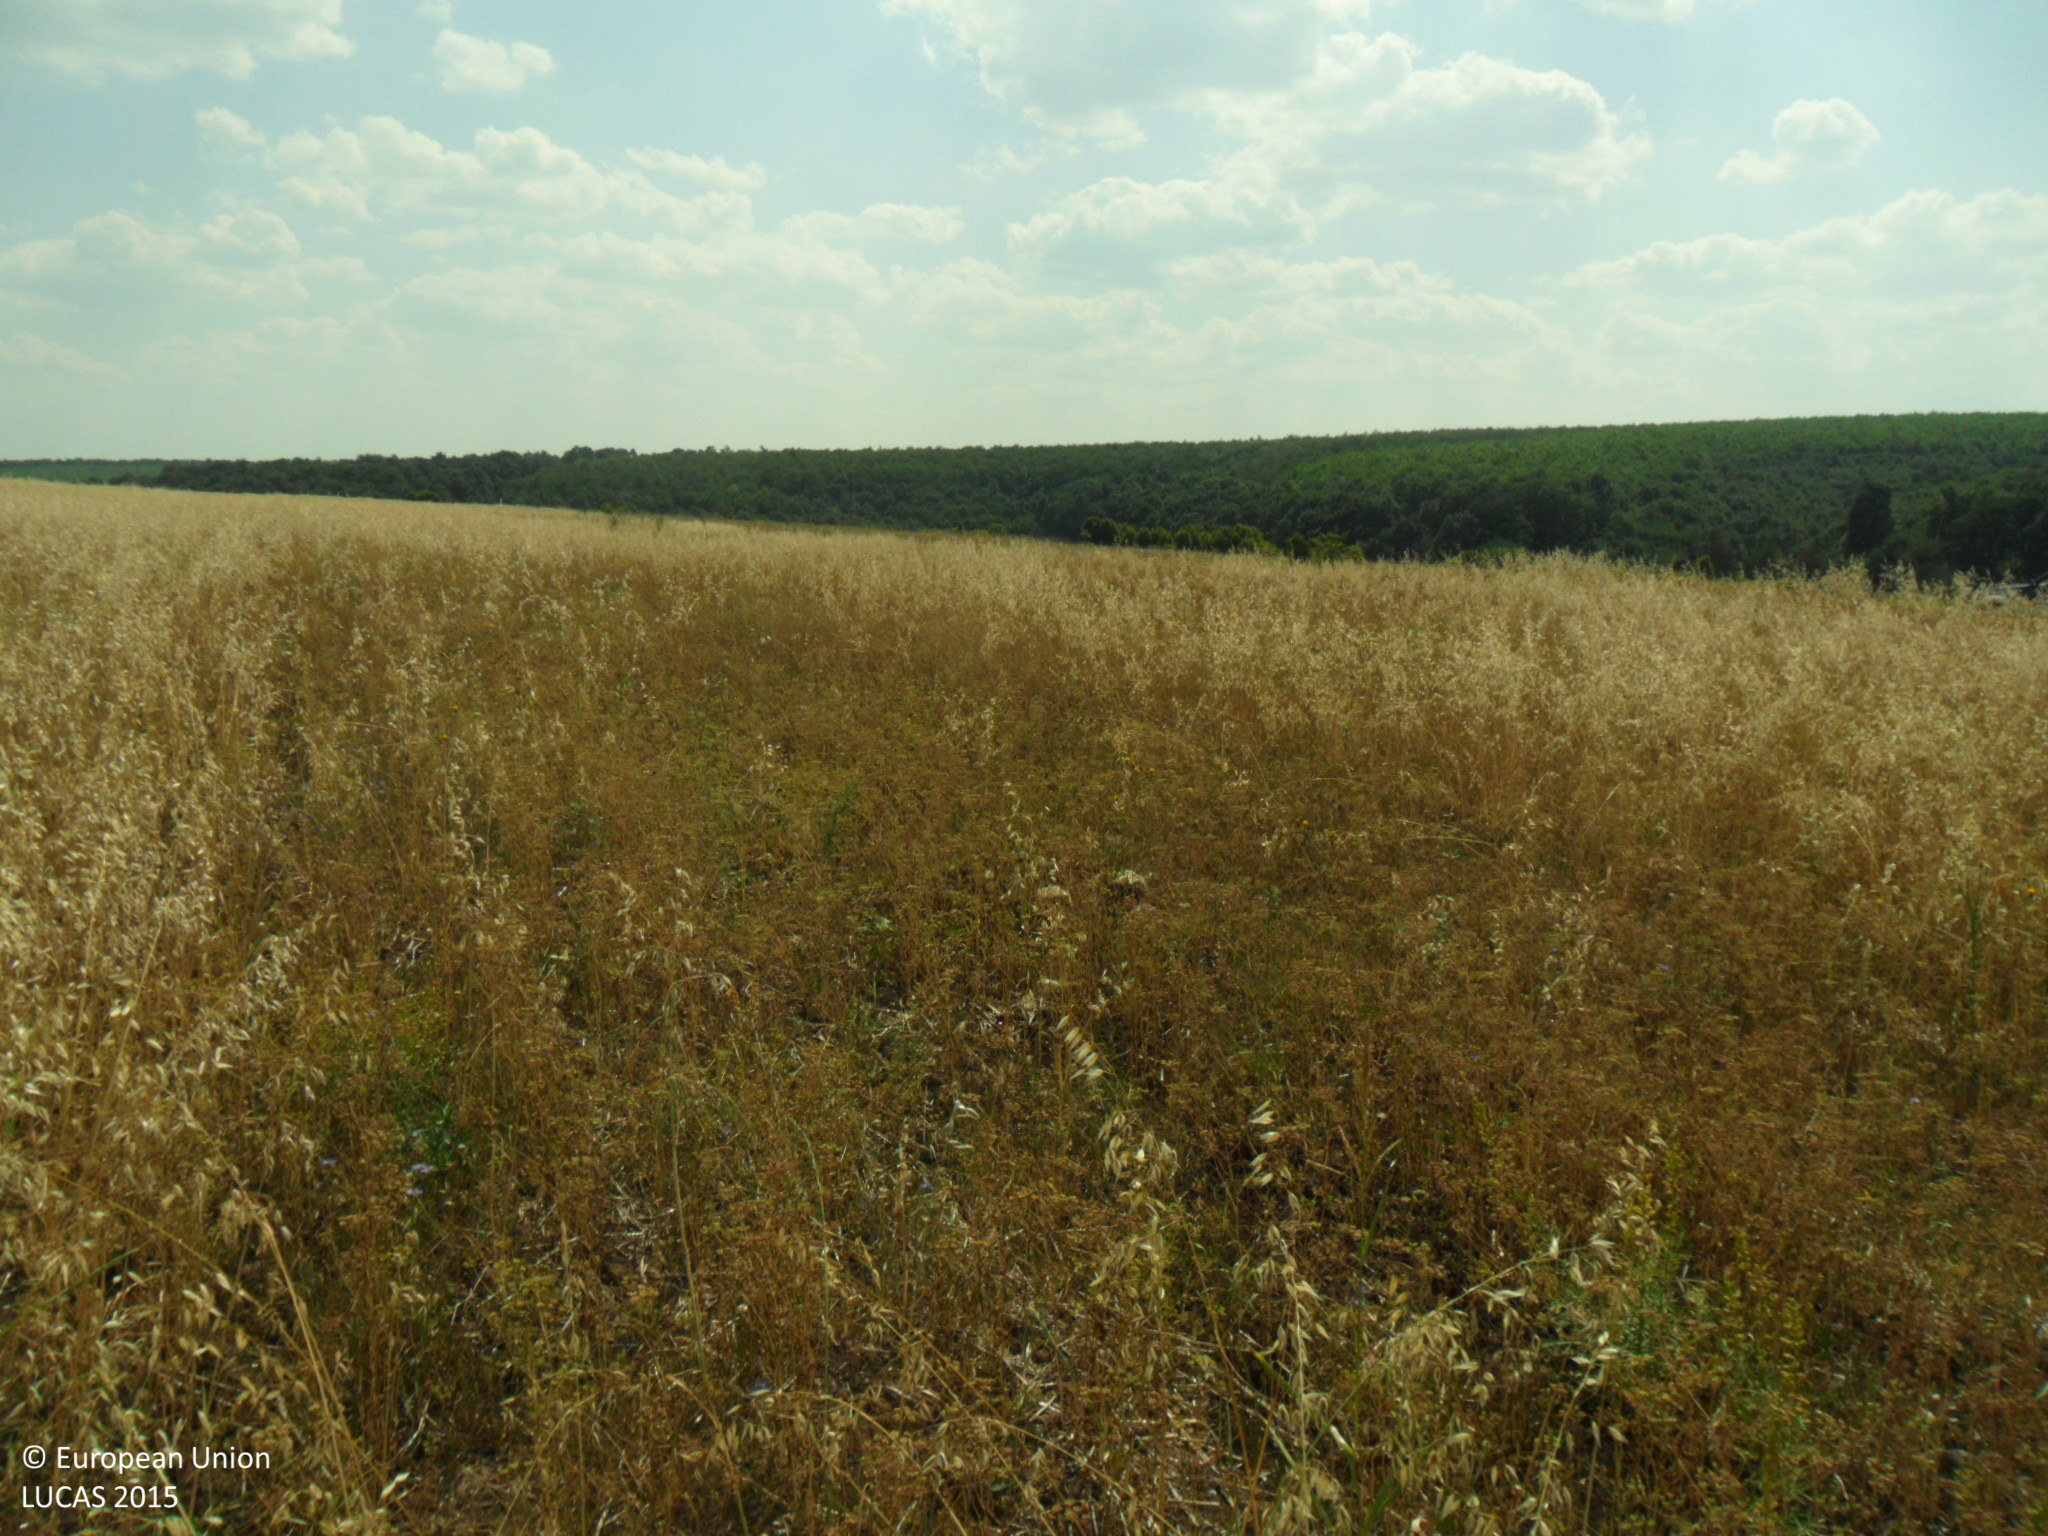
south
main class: Cropland
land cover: Oats
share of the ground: > 75 %
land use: Agriculture (excluding fallow land and kitchen gardens)
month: July
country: BG
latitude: 43.6088
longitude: 27.2608
